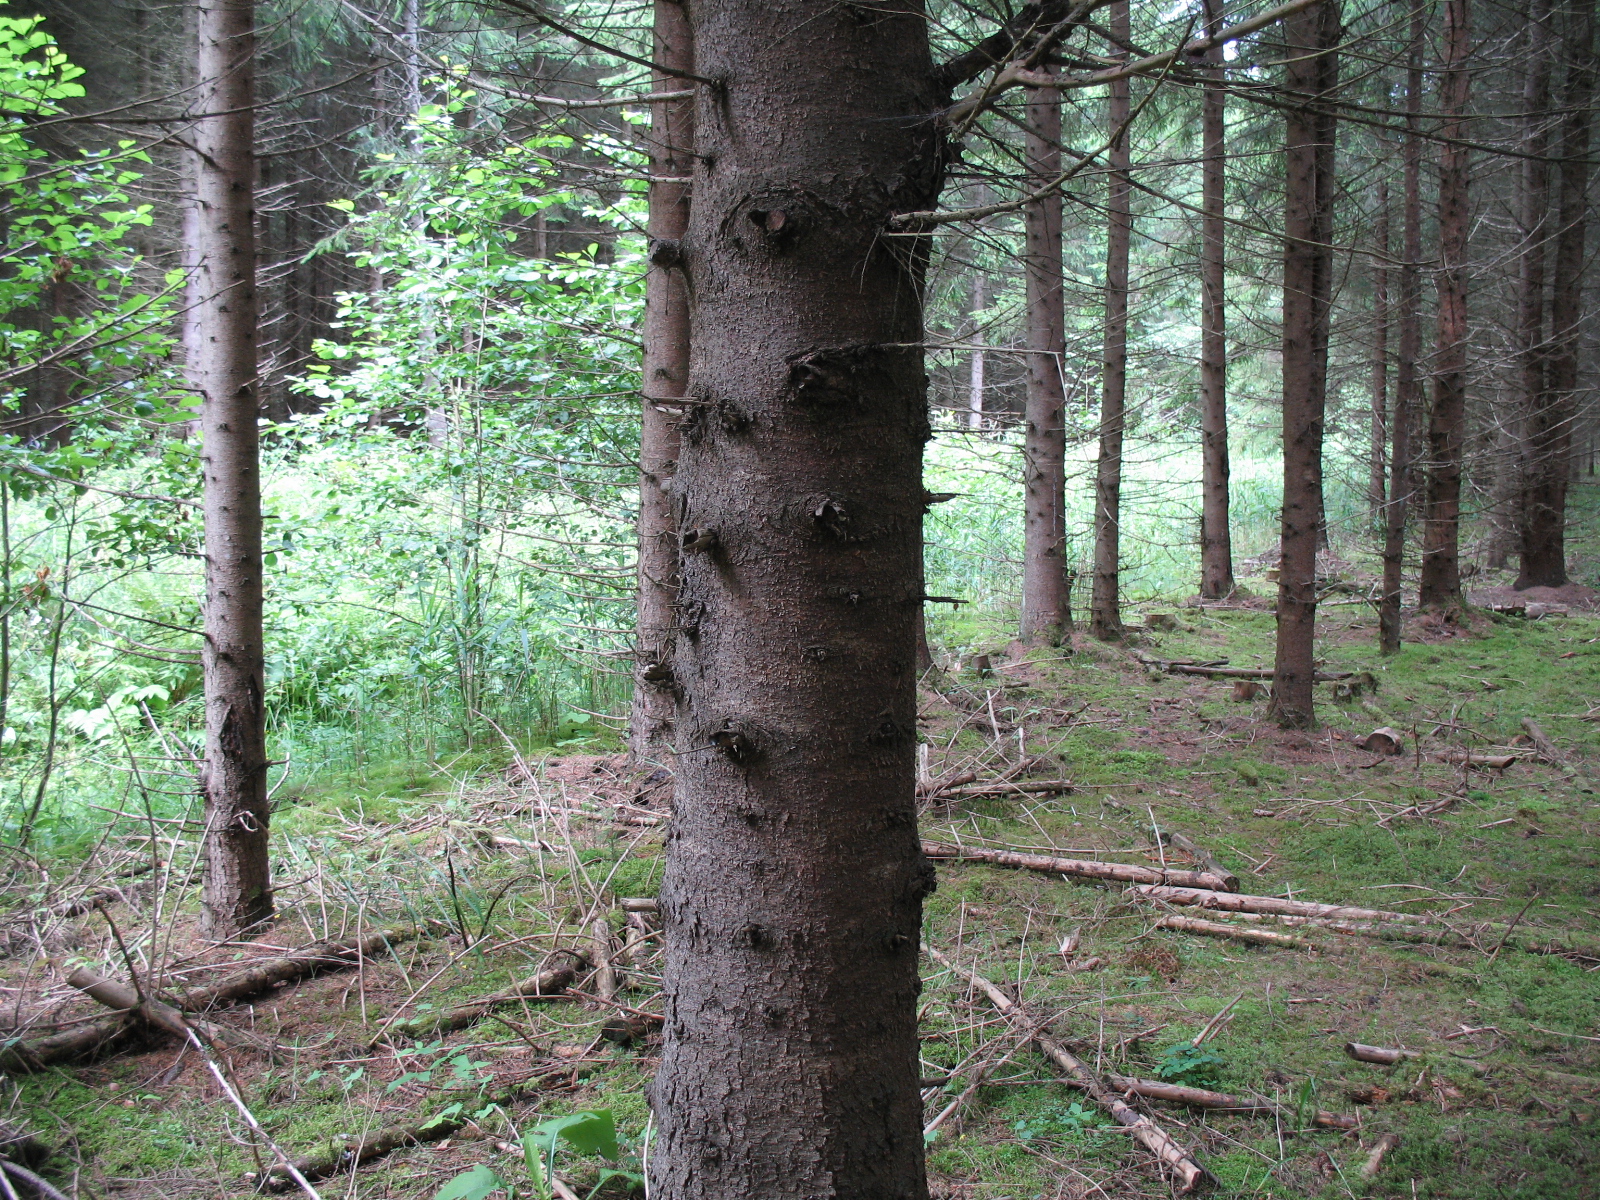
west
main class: Woodland
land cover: Spruce dominated coniferous woodland
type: hemiboreal forest and nemoral coniferous forest and mixed broadleaved-coniferous forest
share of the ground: > 75 %
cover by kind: coniferous forest trees 70 %, herbaceous plants 15 %, lichens and mosses 10 %, broadleaved forest trees 5 %
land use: Forestry
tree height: > 5 m
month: July
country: LV
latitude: 56.3875
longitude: 25.0930
